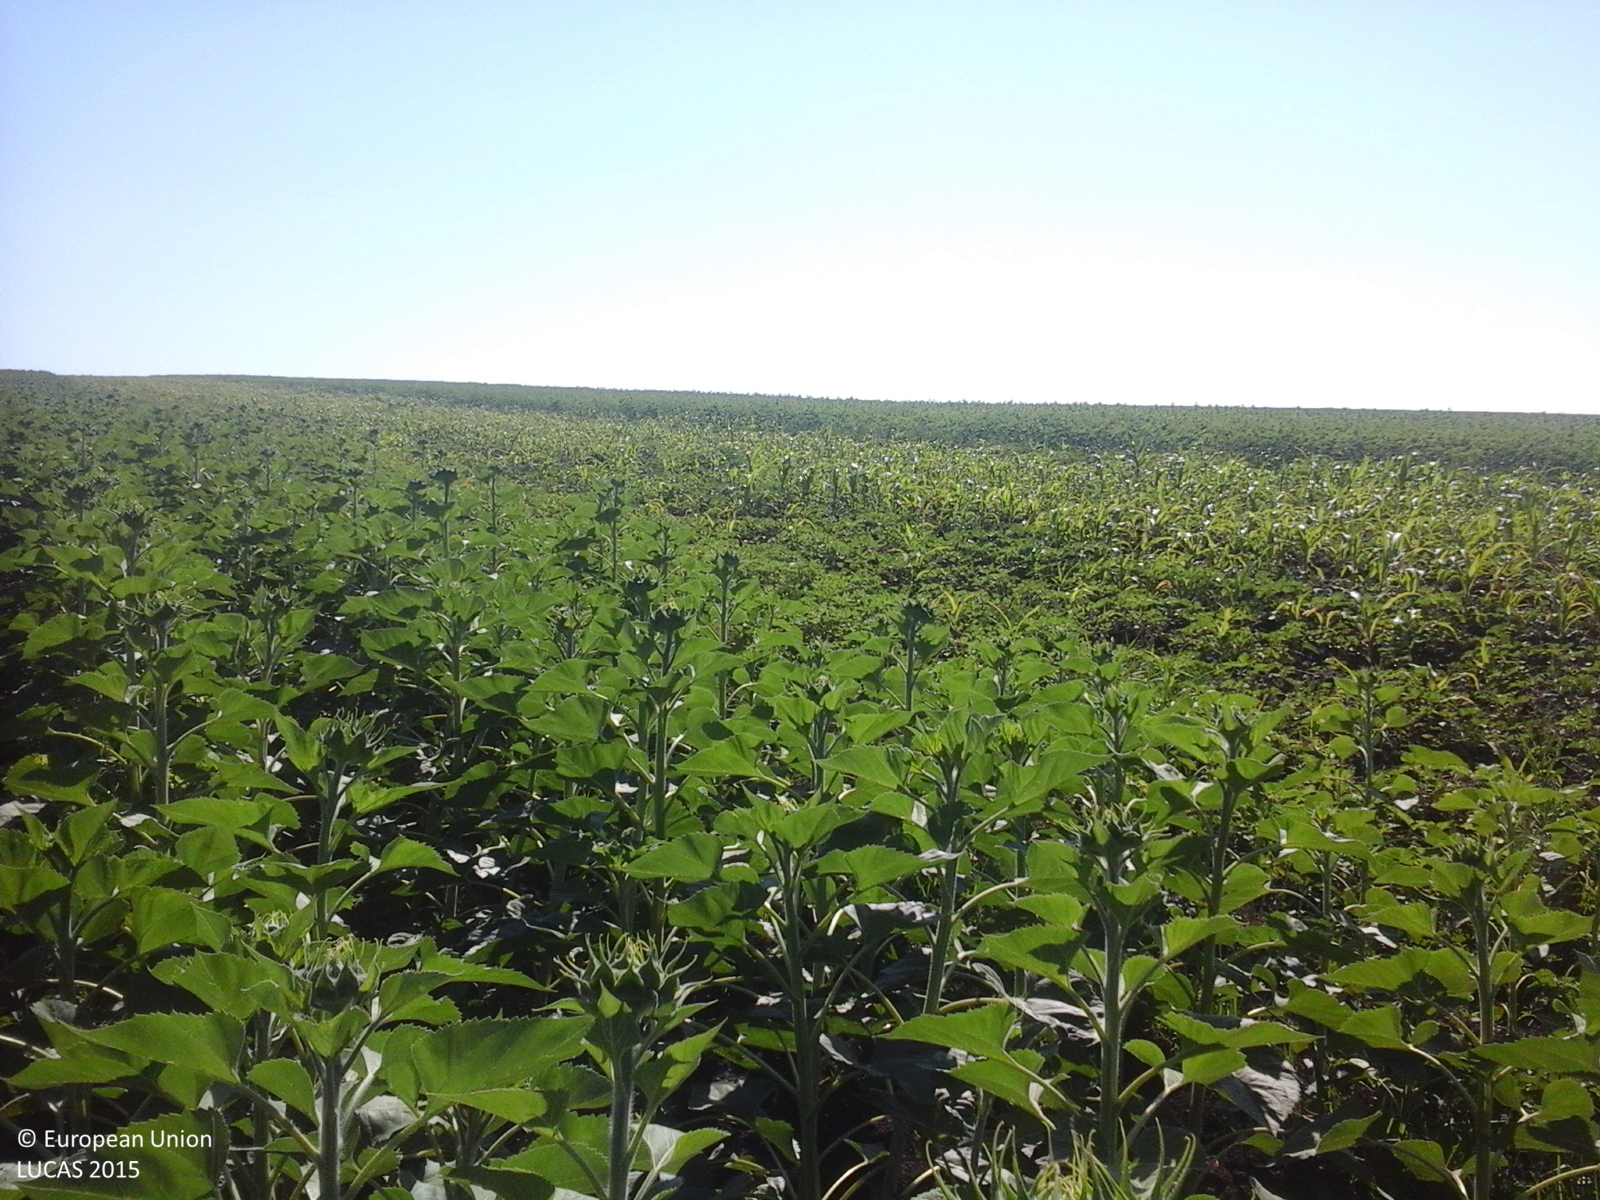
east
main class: Cropland
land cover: Sunflower
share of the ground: > 75 %
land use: Agriculture (excluding fallow land and kitchen gardens)
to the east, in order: Sunflower; Maize; Sunflower; Soya
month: June
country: RO
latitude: 47.7235
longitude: 27.0783
